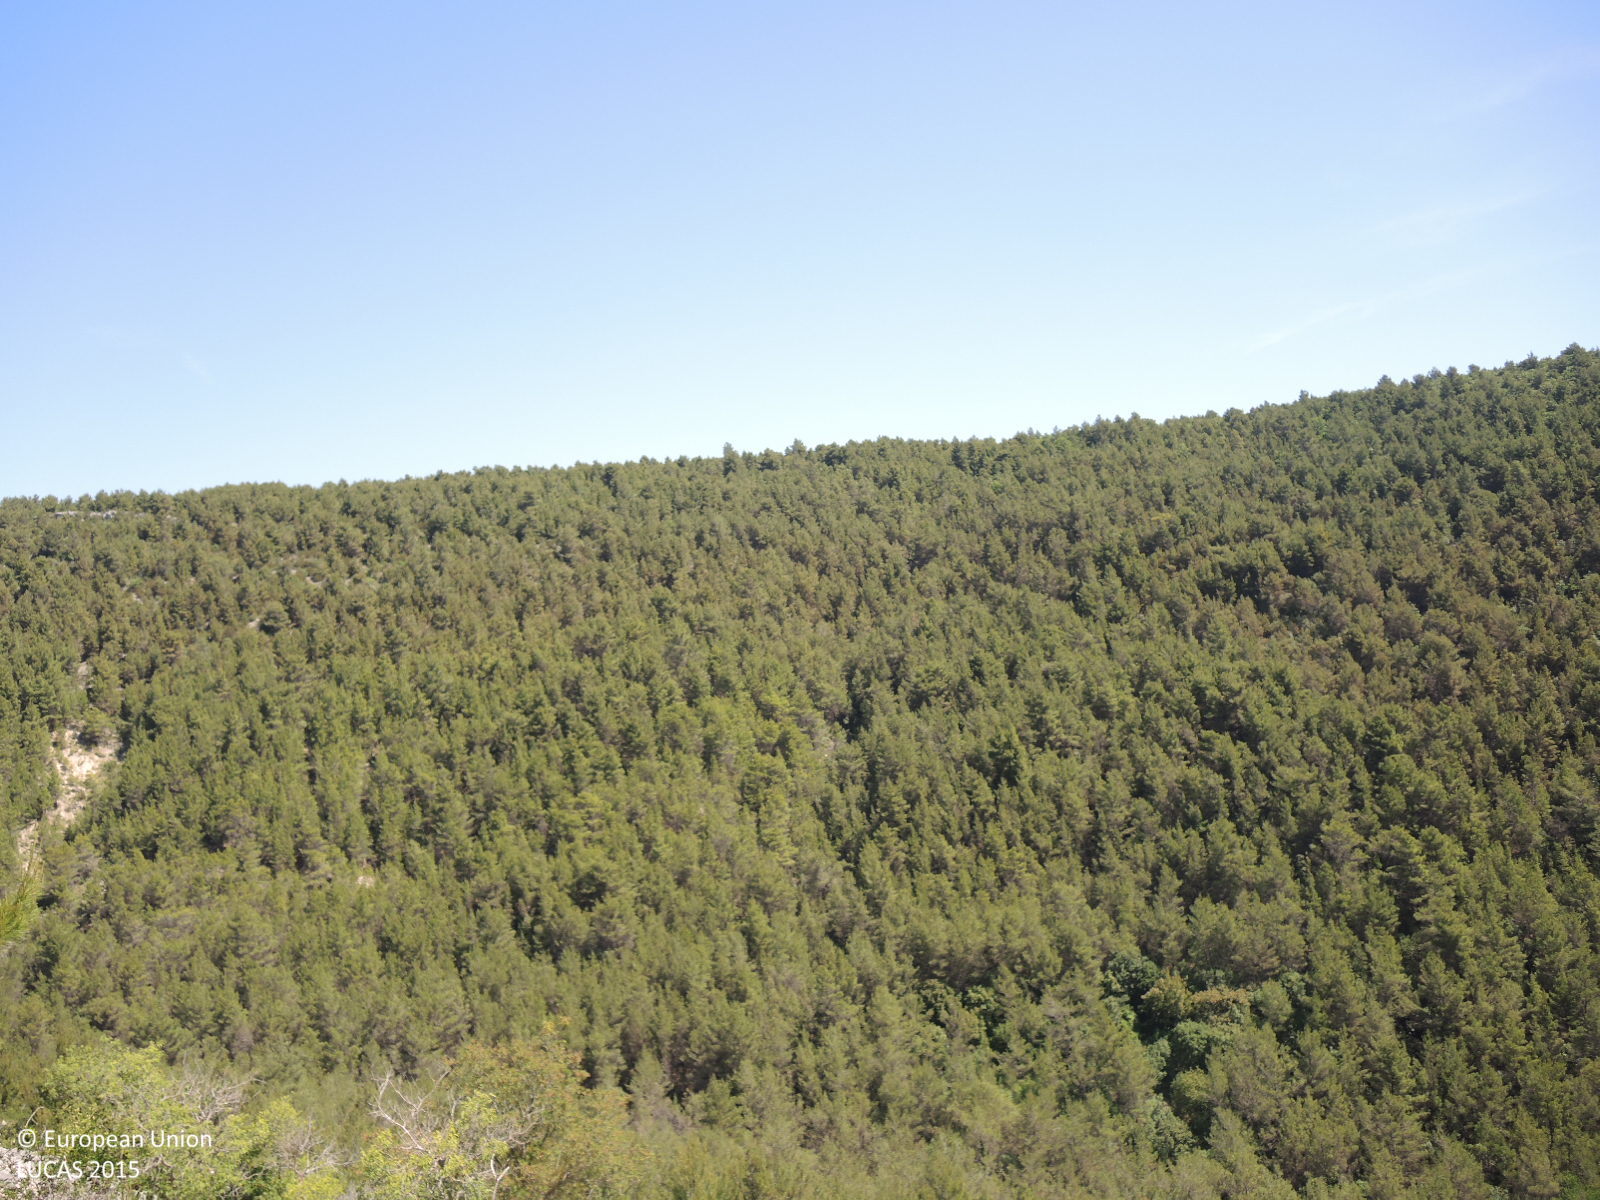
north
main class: Woodland
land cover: Pine dominated coniferous woodland
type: coniferous forest of the mediterranean region
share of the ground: 10 - 25 %
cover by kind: unconsolidated bare surface 65 %, coniferous forest trees 20 %, consolidated bare surface 10 %, shrubs 5 %
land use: Semi-natural and natural areas not in use
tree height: > 5 m
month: May
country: HR
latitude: 43.8349
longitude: 15.9734
